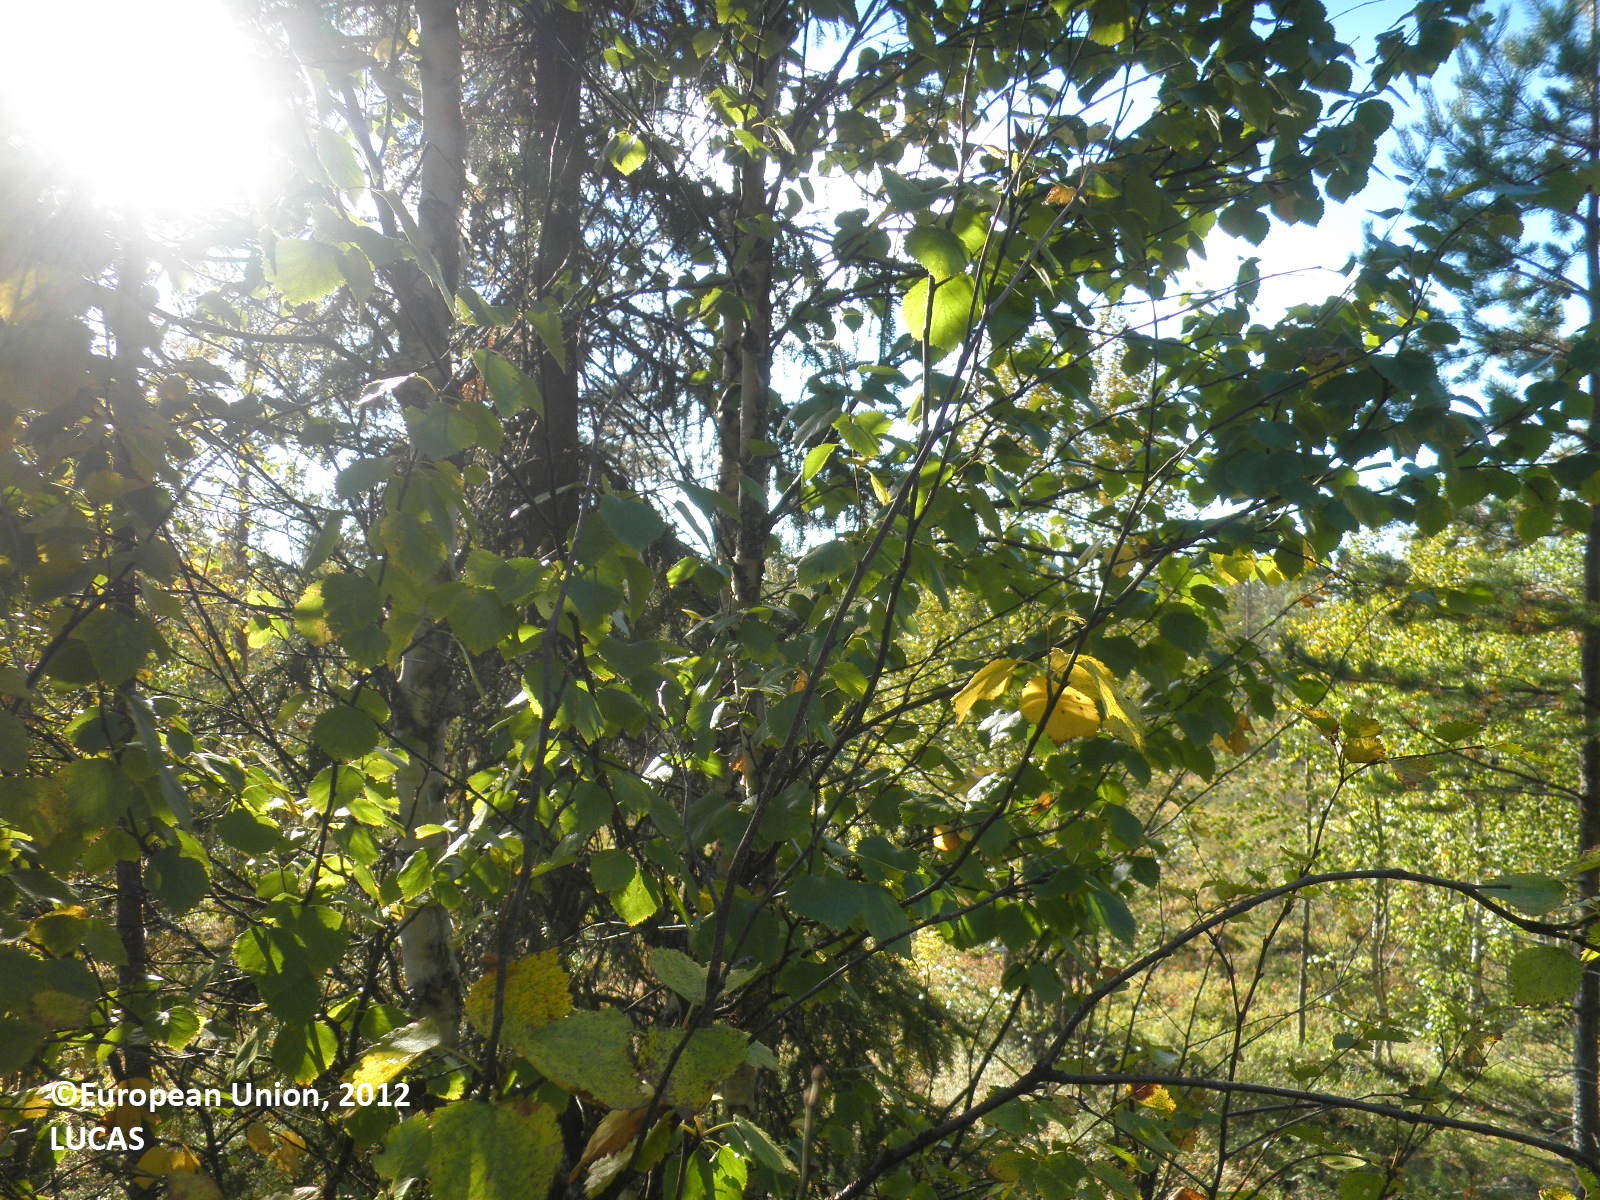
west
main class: Woodland
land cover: Pine dominated mixed woodland
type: boreal forest
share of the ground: 50 - 75 %
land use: Forestry
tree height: > 5 m
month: August
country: FI
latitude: 67.6957
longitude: 27.2041
